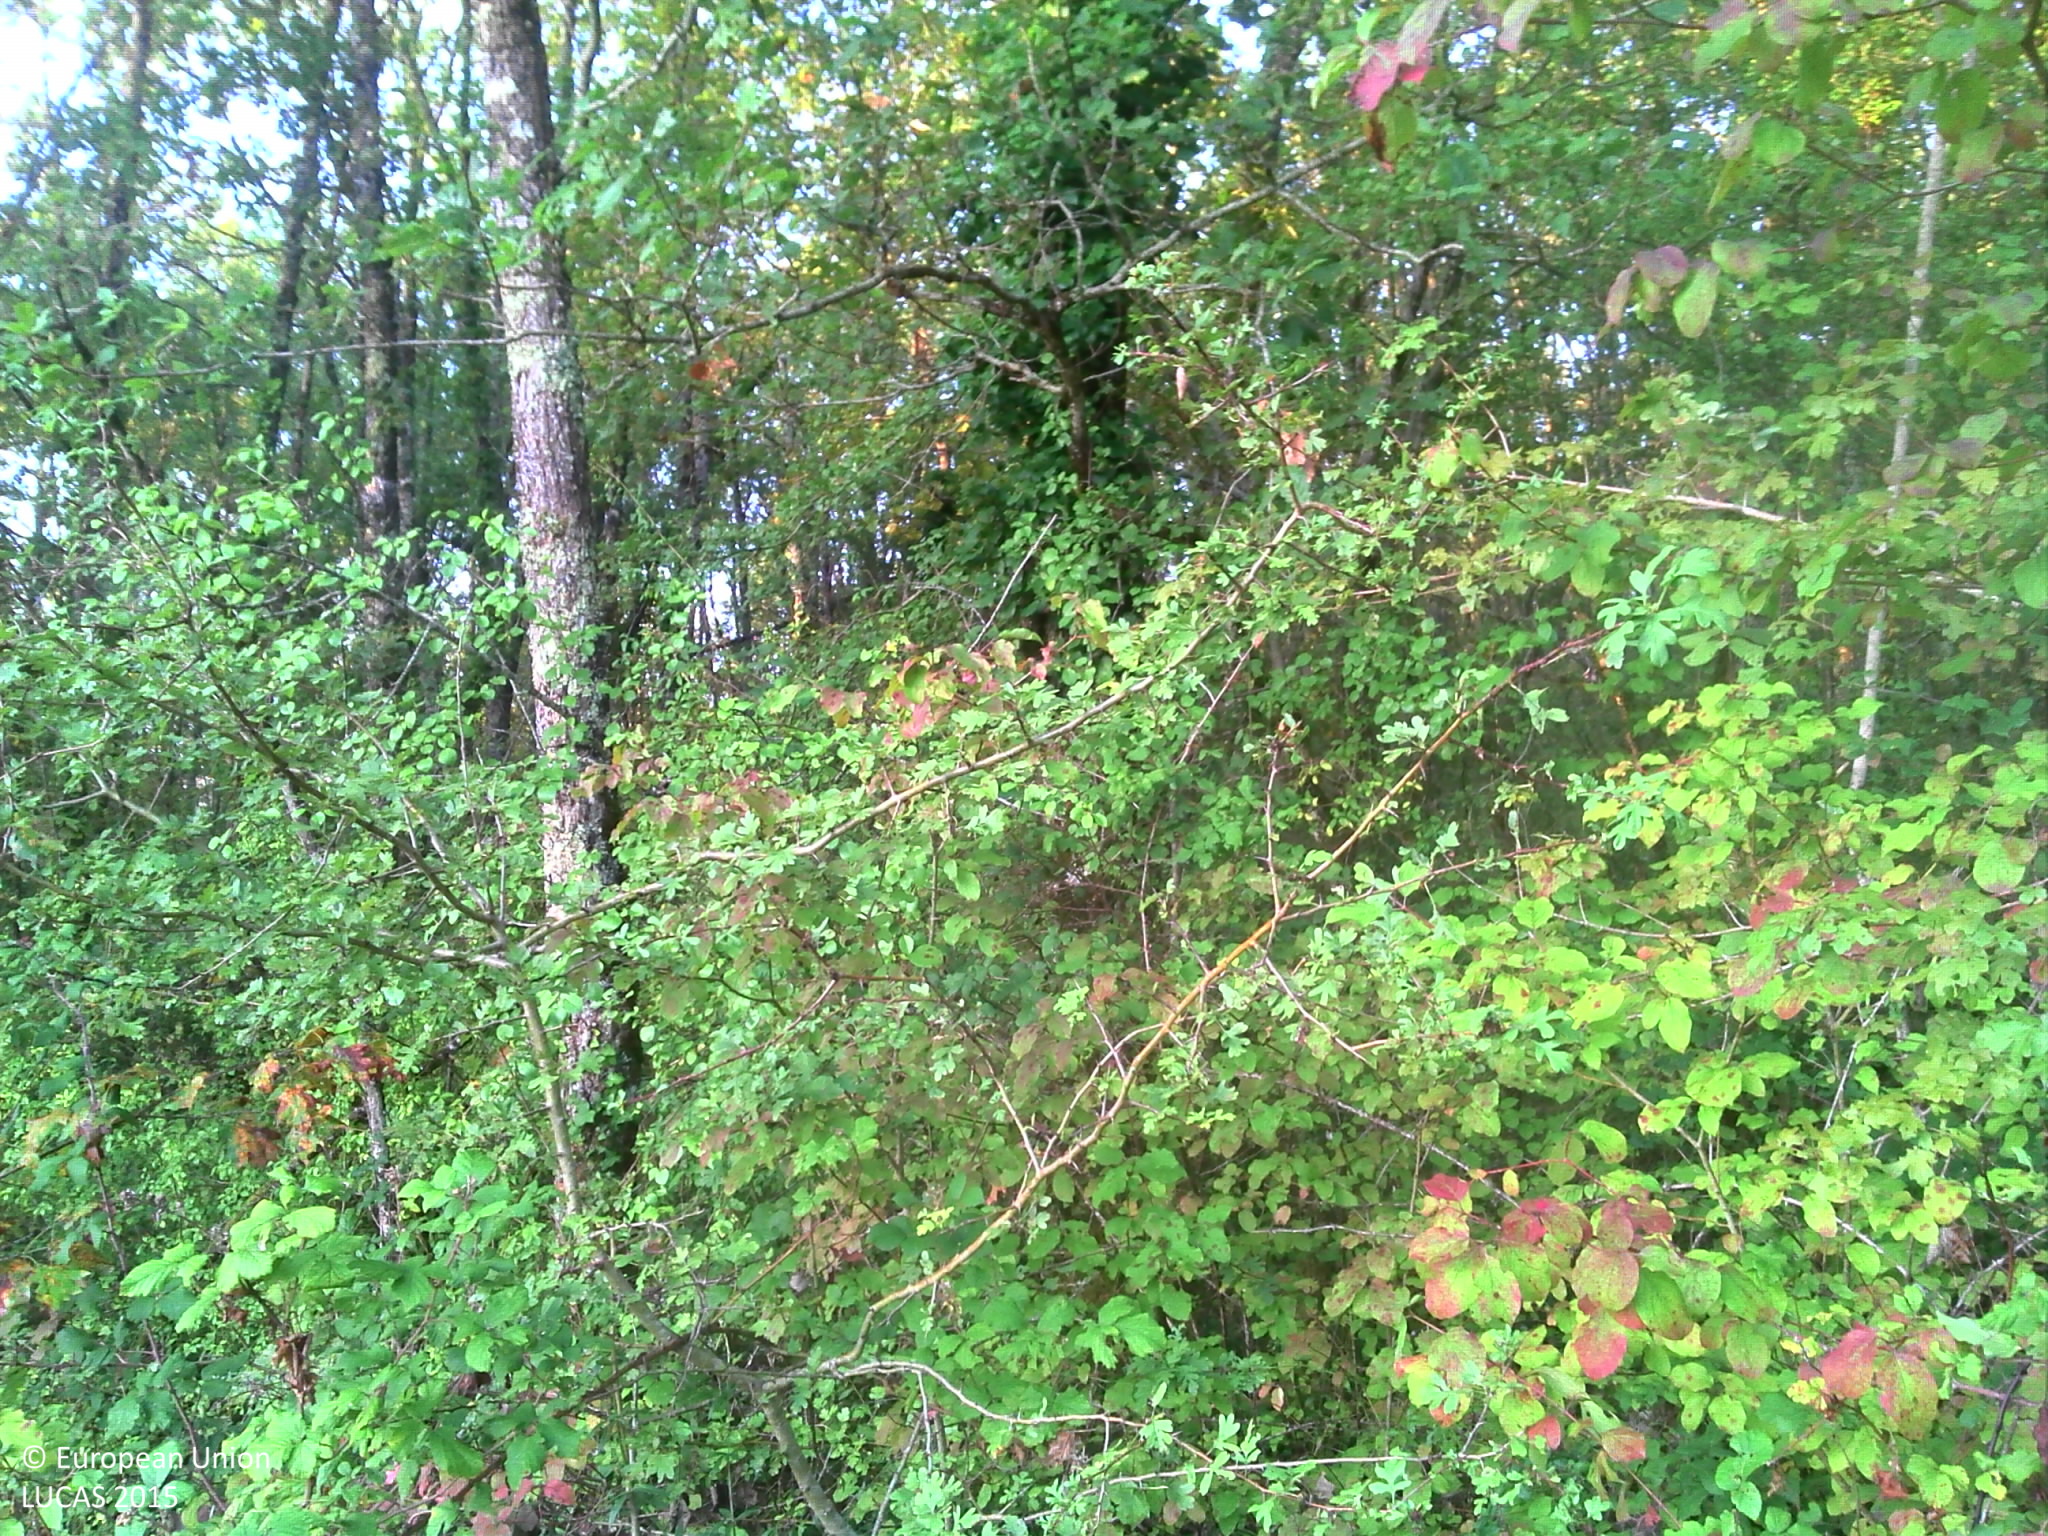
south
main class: Grassland
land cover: Grassland without tree/shrub cover
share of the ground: > 75 %
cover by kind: herbaceous plants 100 %
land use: Agriculture (excluding fallow land and kitchen gardens)
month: August
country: FR
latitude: 45.0050
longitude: 1.5848
